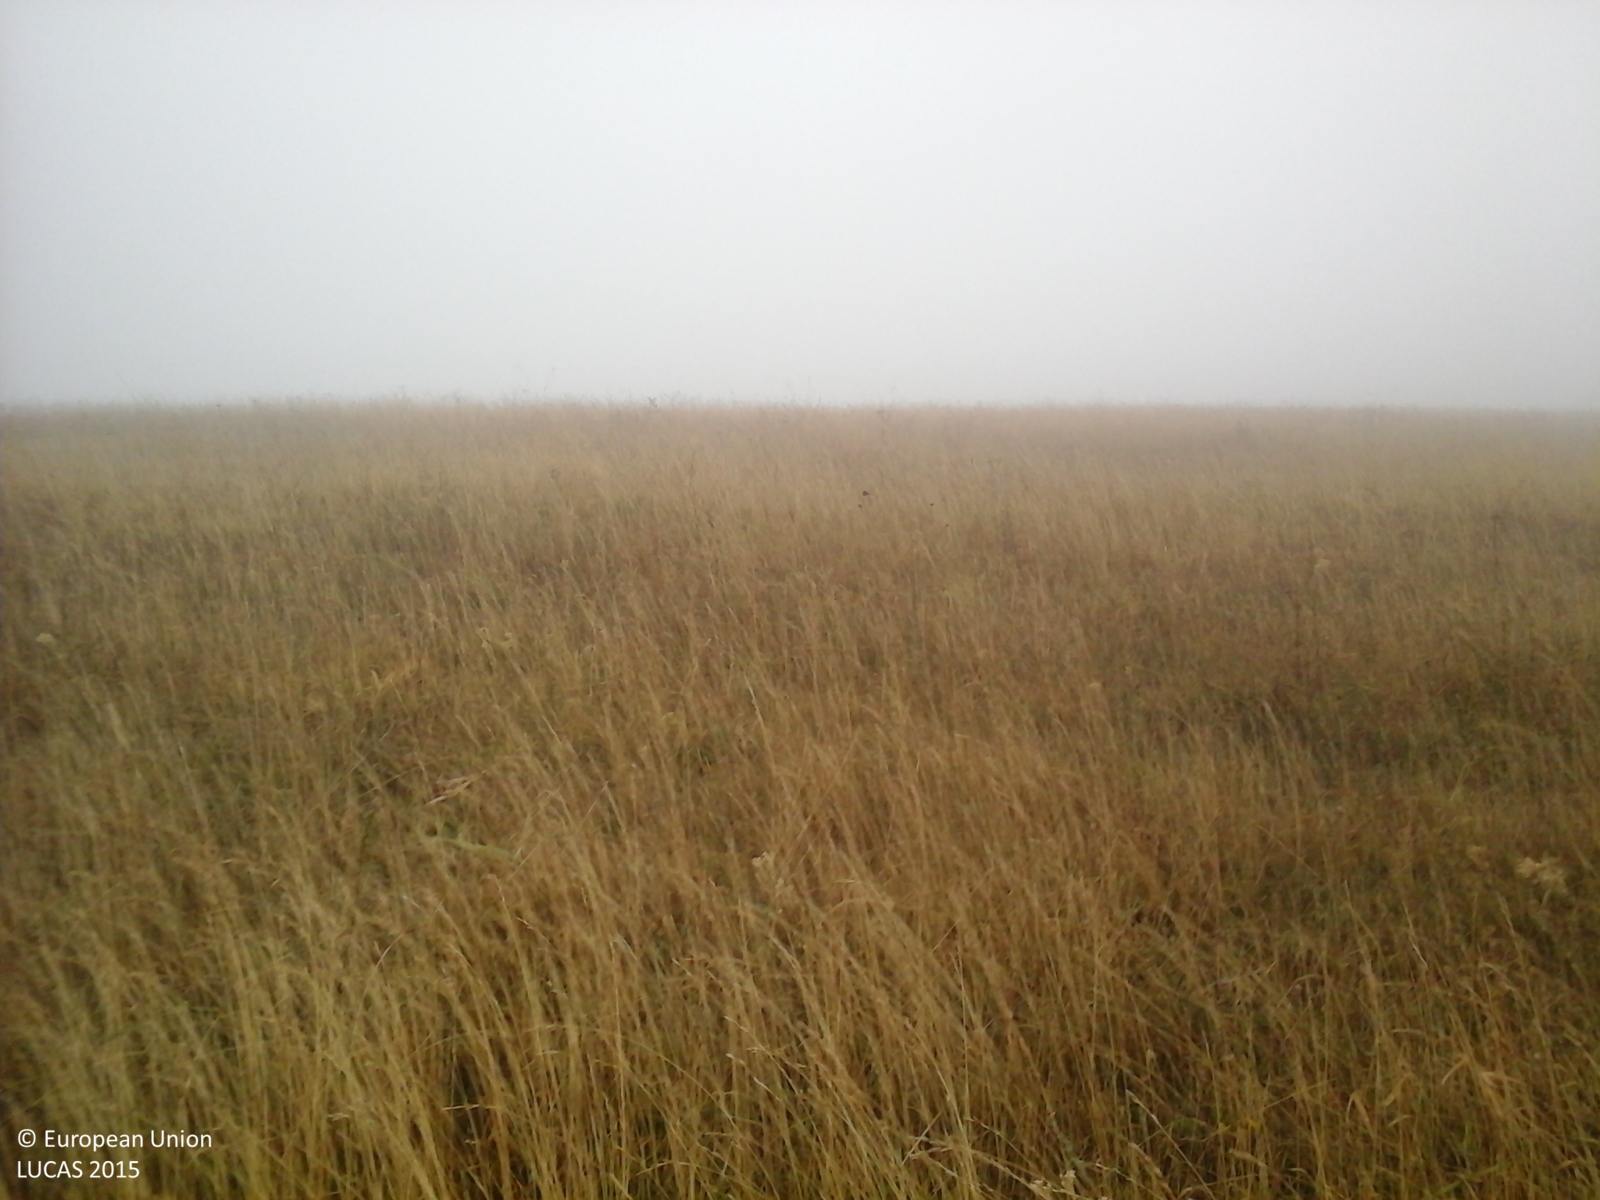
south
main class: Grassland
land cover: Grassland without tree/shrub cover
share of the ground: > 75 %
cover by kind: herbaceous plants 100 %
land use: Agriculture (excluding fallow land and kitchen gardens)
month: September
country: IT
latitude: 43.4408
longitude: 12.9947
